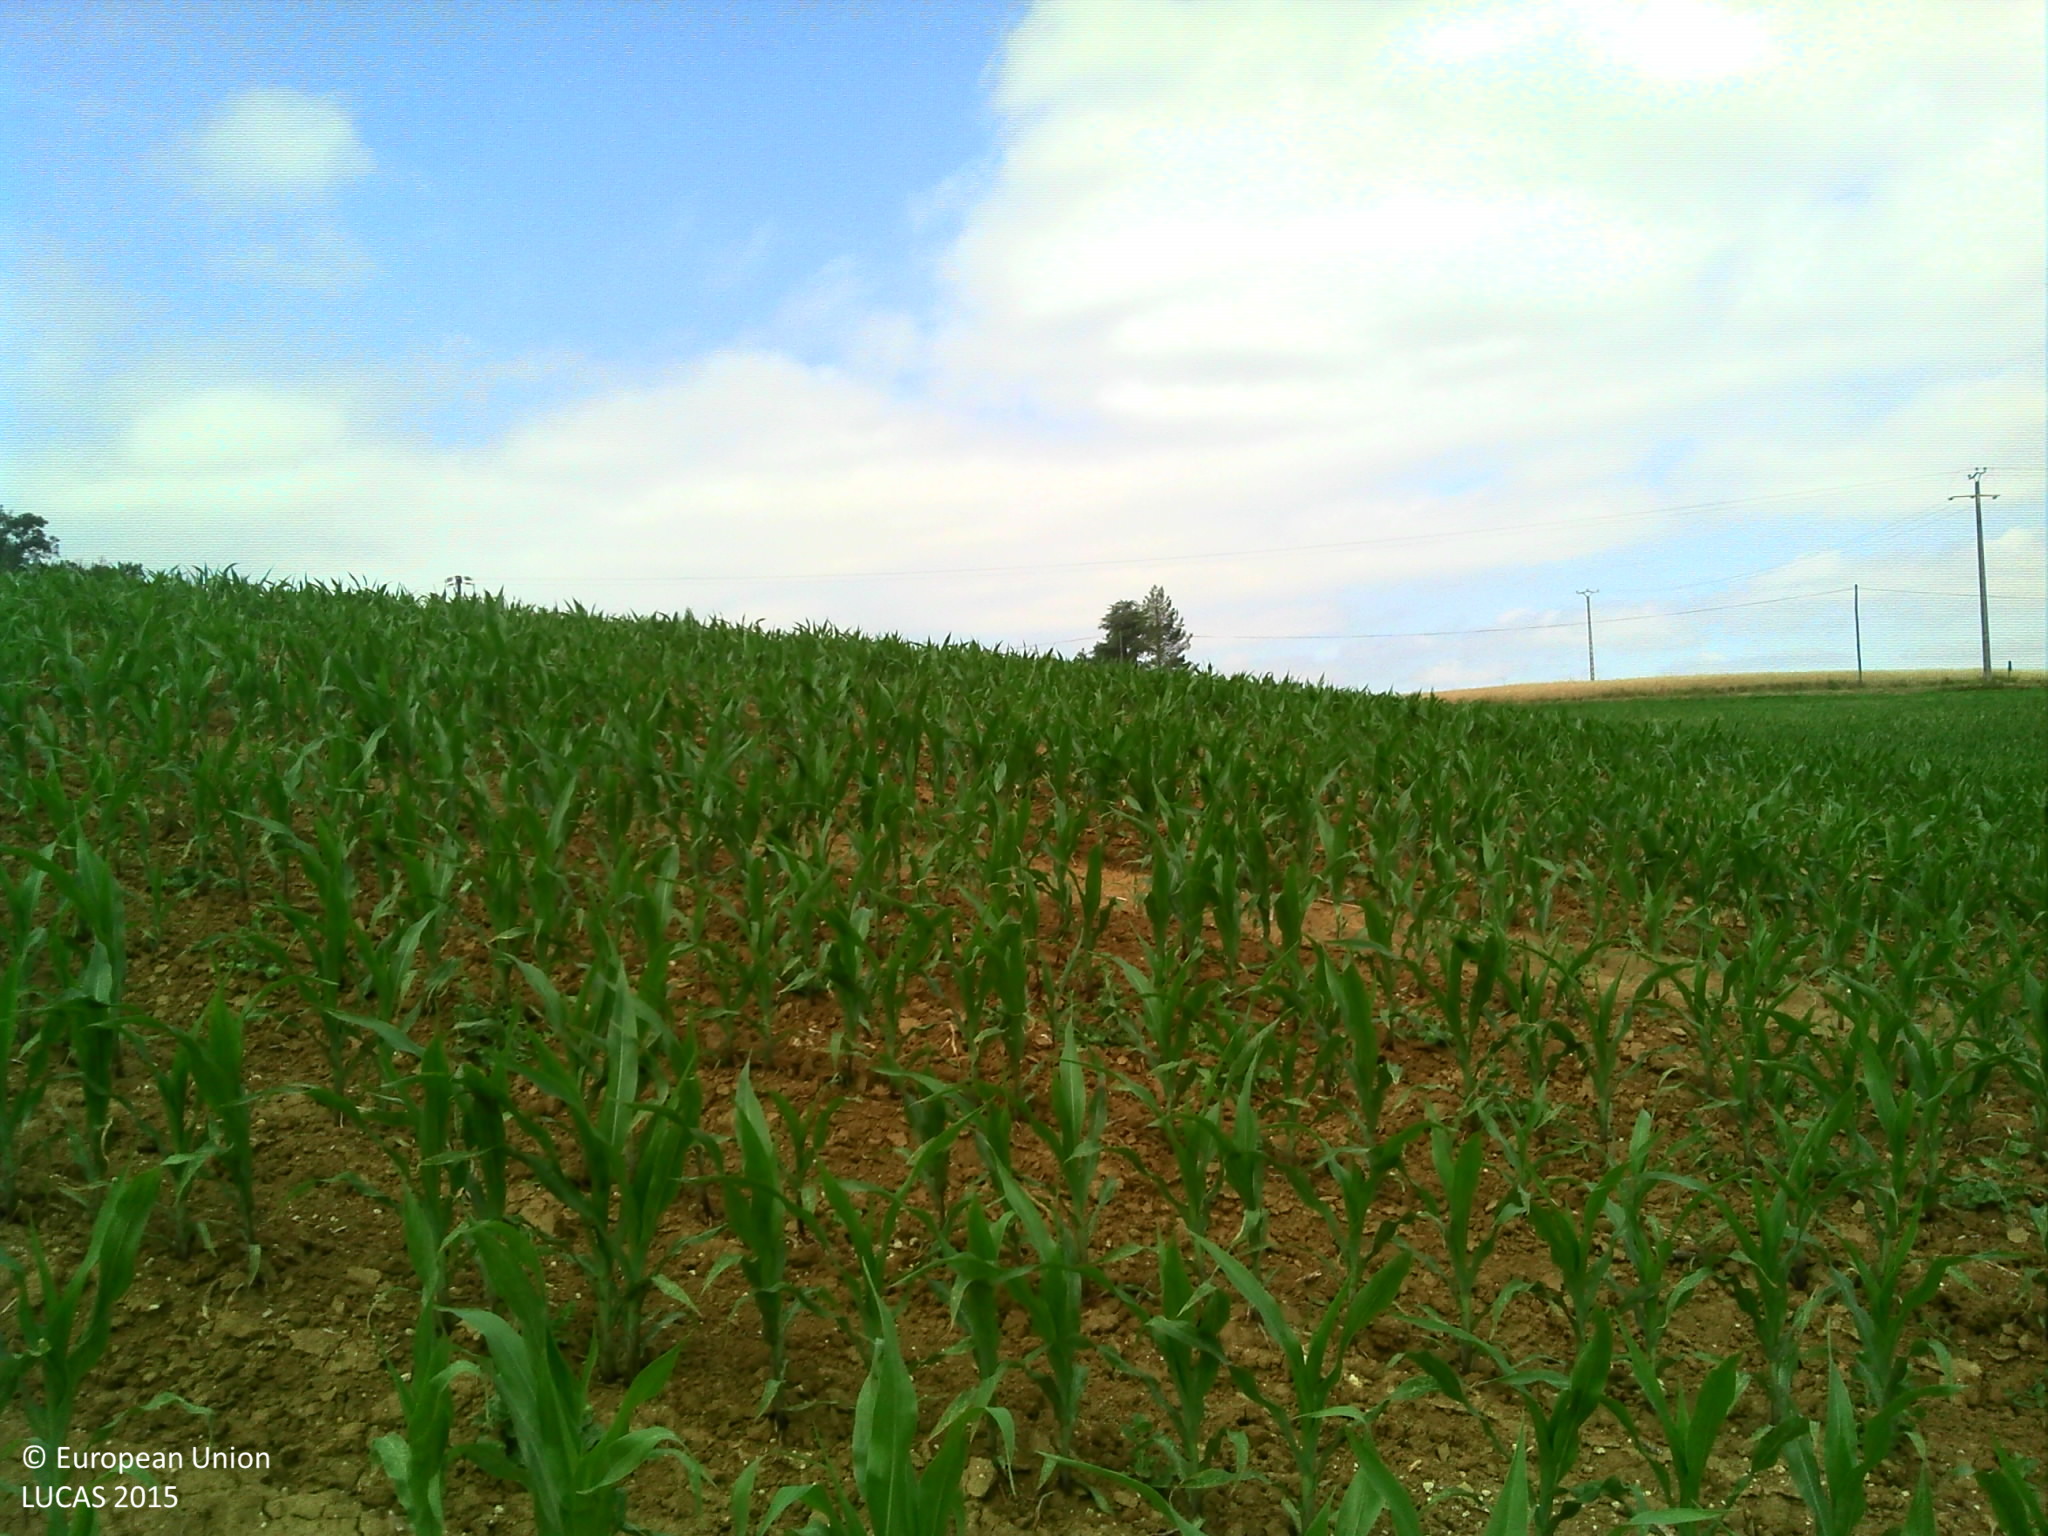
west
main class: Cropland
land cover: Maize
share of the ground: > 75 %
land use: Agriculture (excluding fallow land and kitchen gardens)
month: June
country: FR
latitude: 44.1323
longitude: 0.9103
